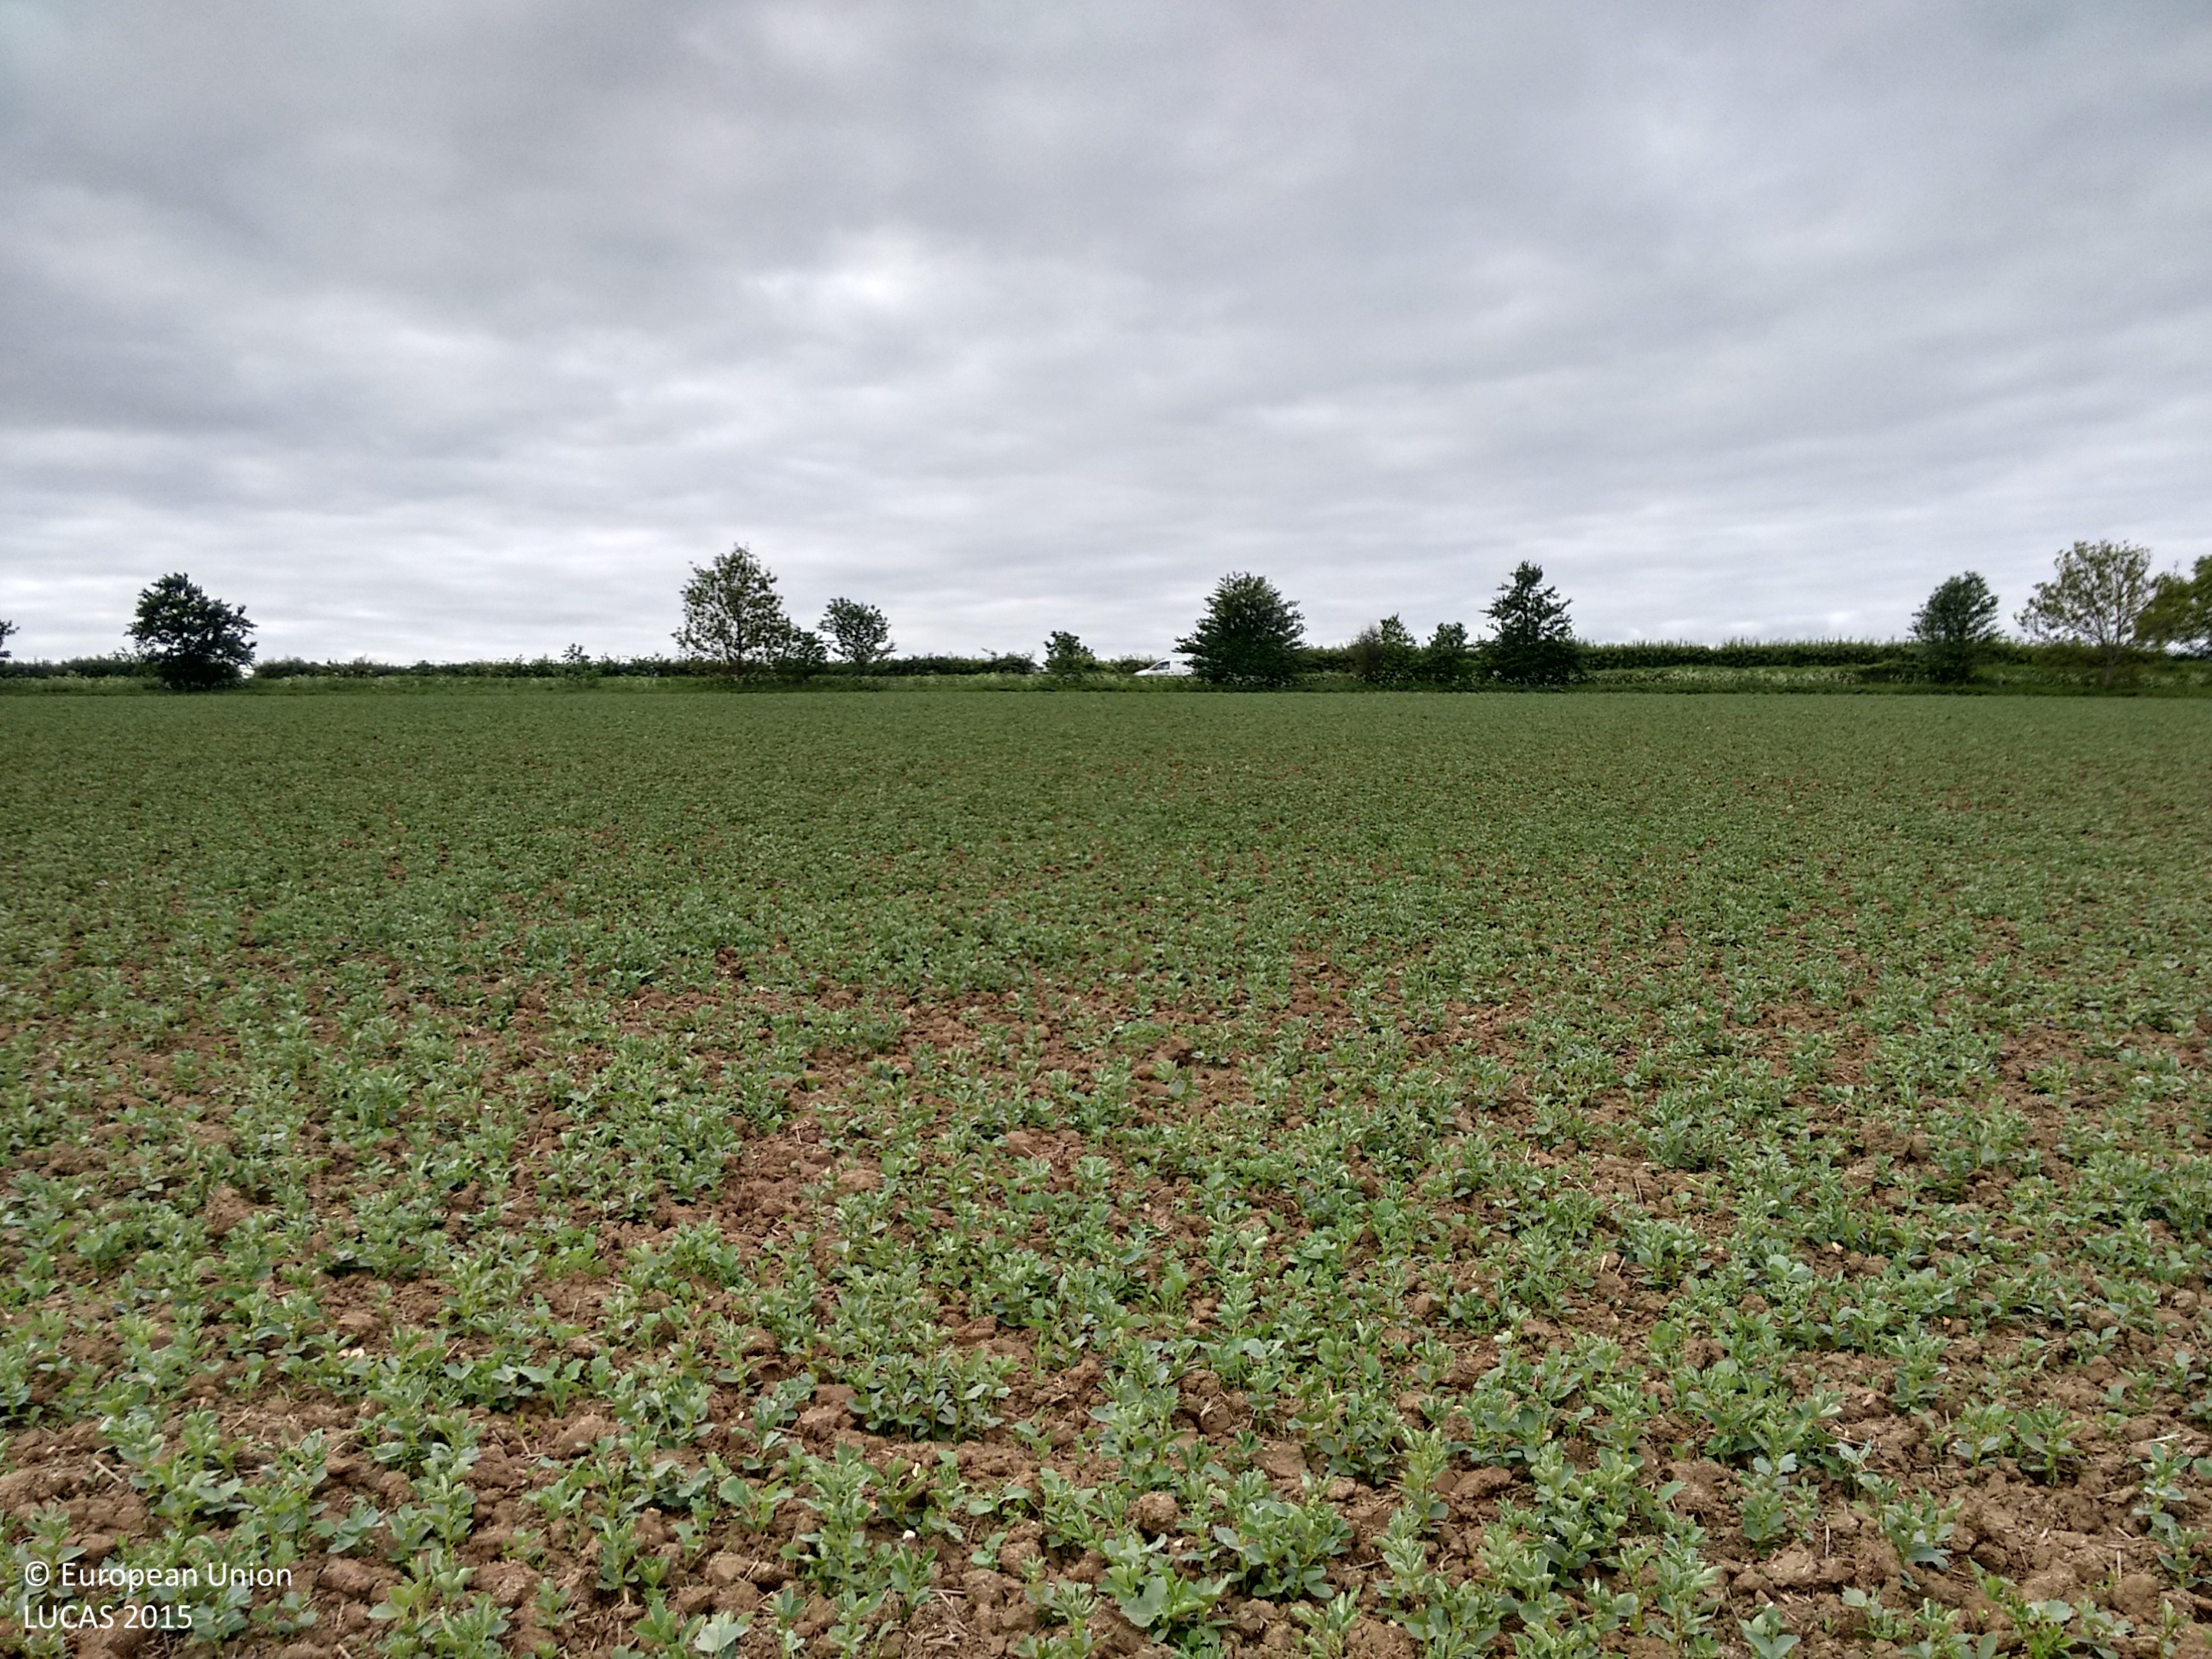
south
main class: Cropland
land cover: Dry pulses
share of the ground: 50 - 75 %
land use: Agriculture (excluding fallow land and kitchen gardens)
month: May
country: GB
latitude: 53.4590
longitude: -0.6266
